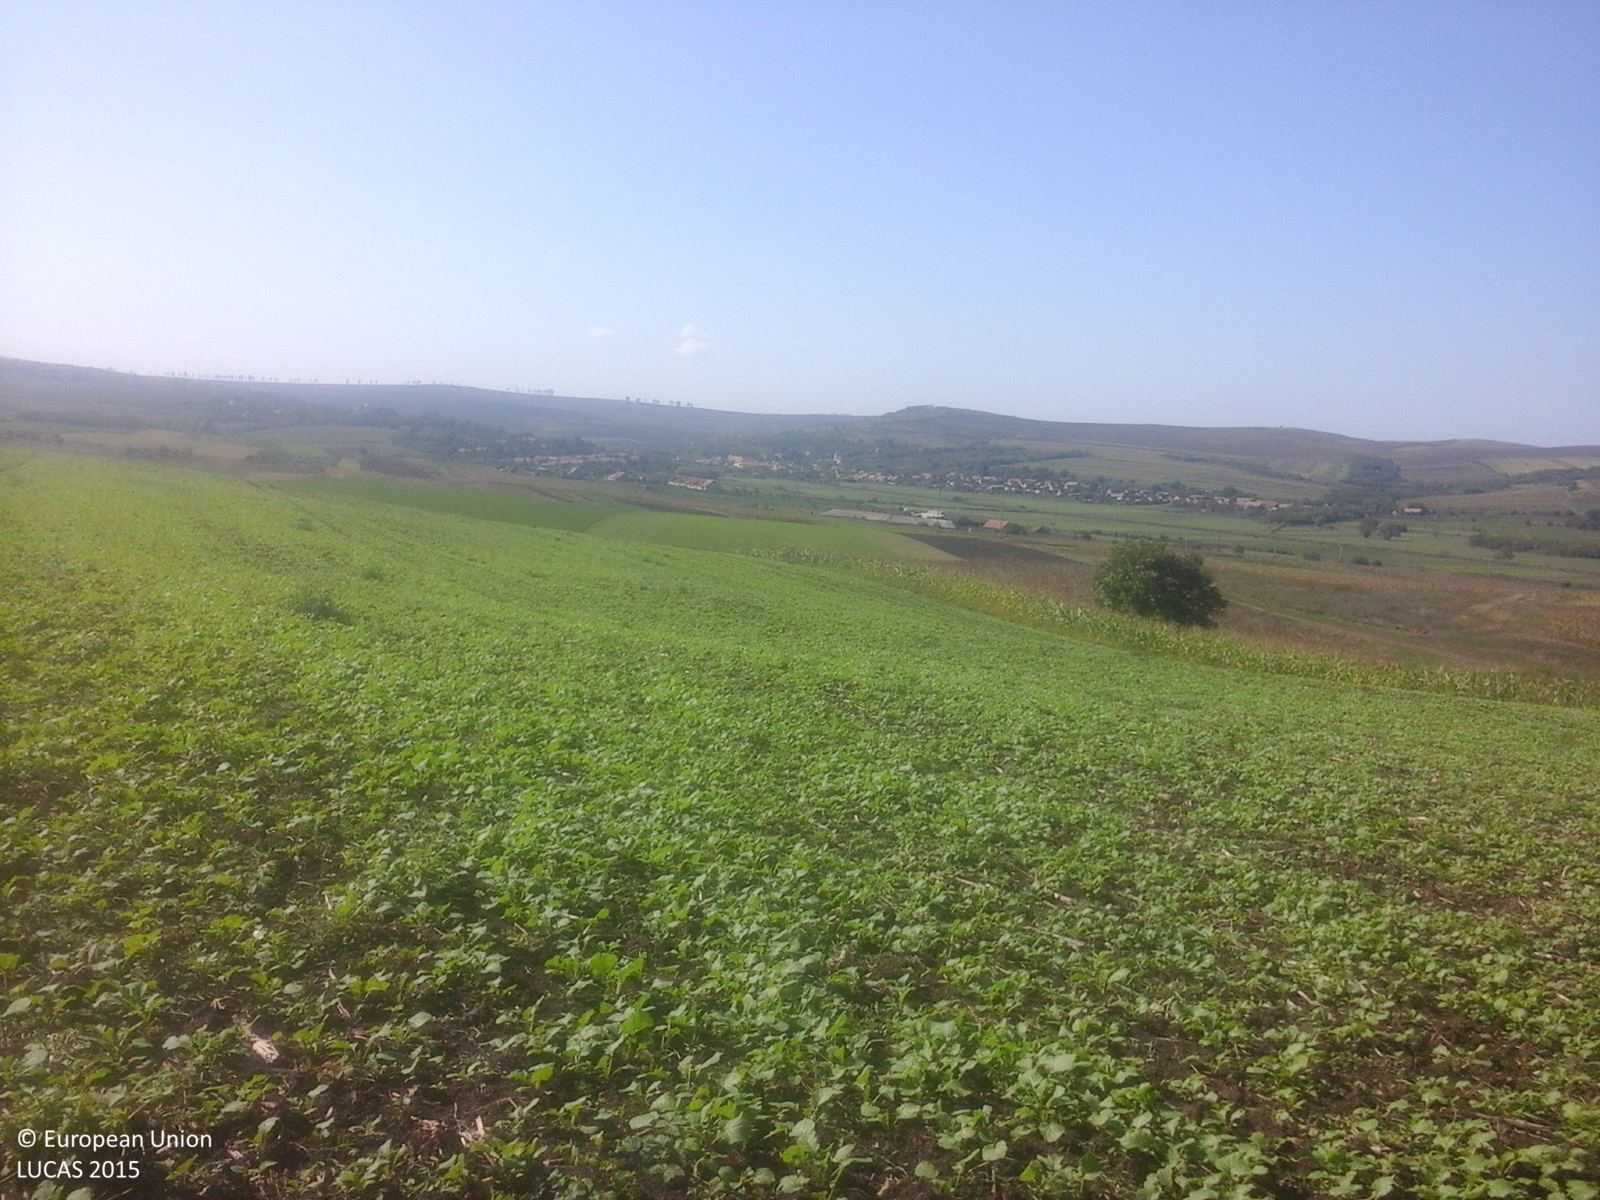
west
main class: Cropland
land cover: Rape and turnip rape
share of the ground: > 75 %
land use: Agriculture (excluding fallow land and kitchen gardens)
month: October
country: RO
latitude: 45.9732
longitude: 23.9991
